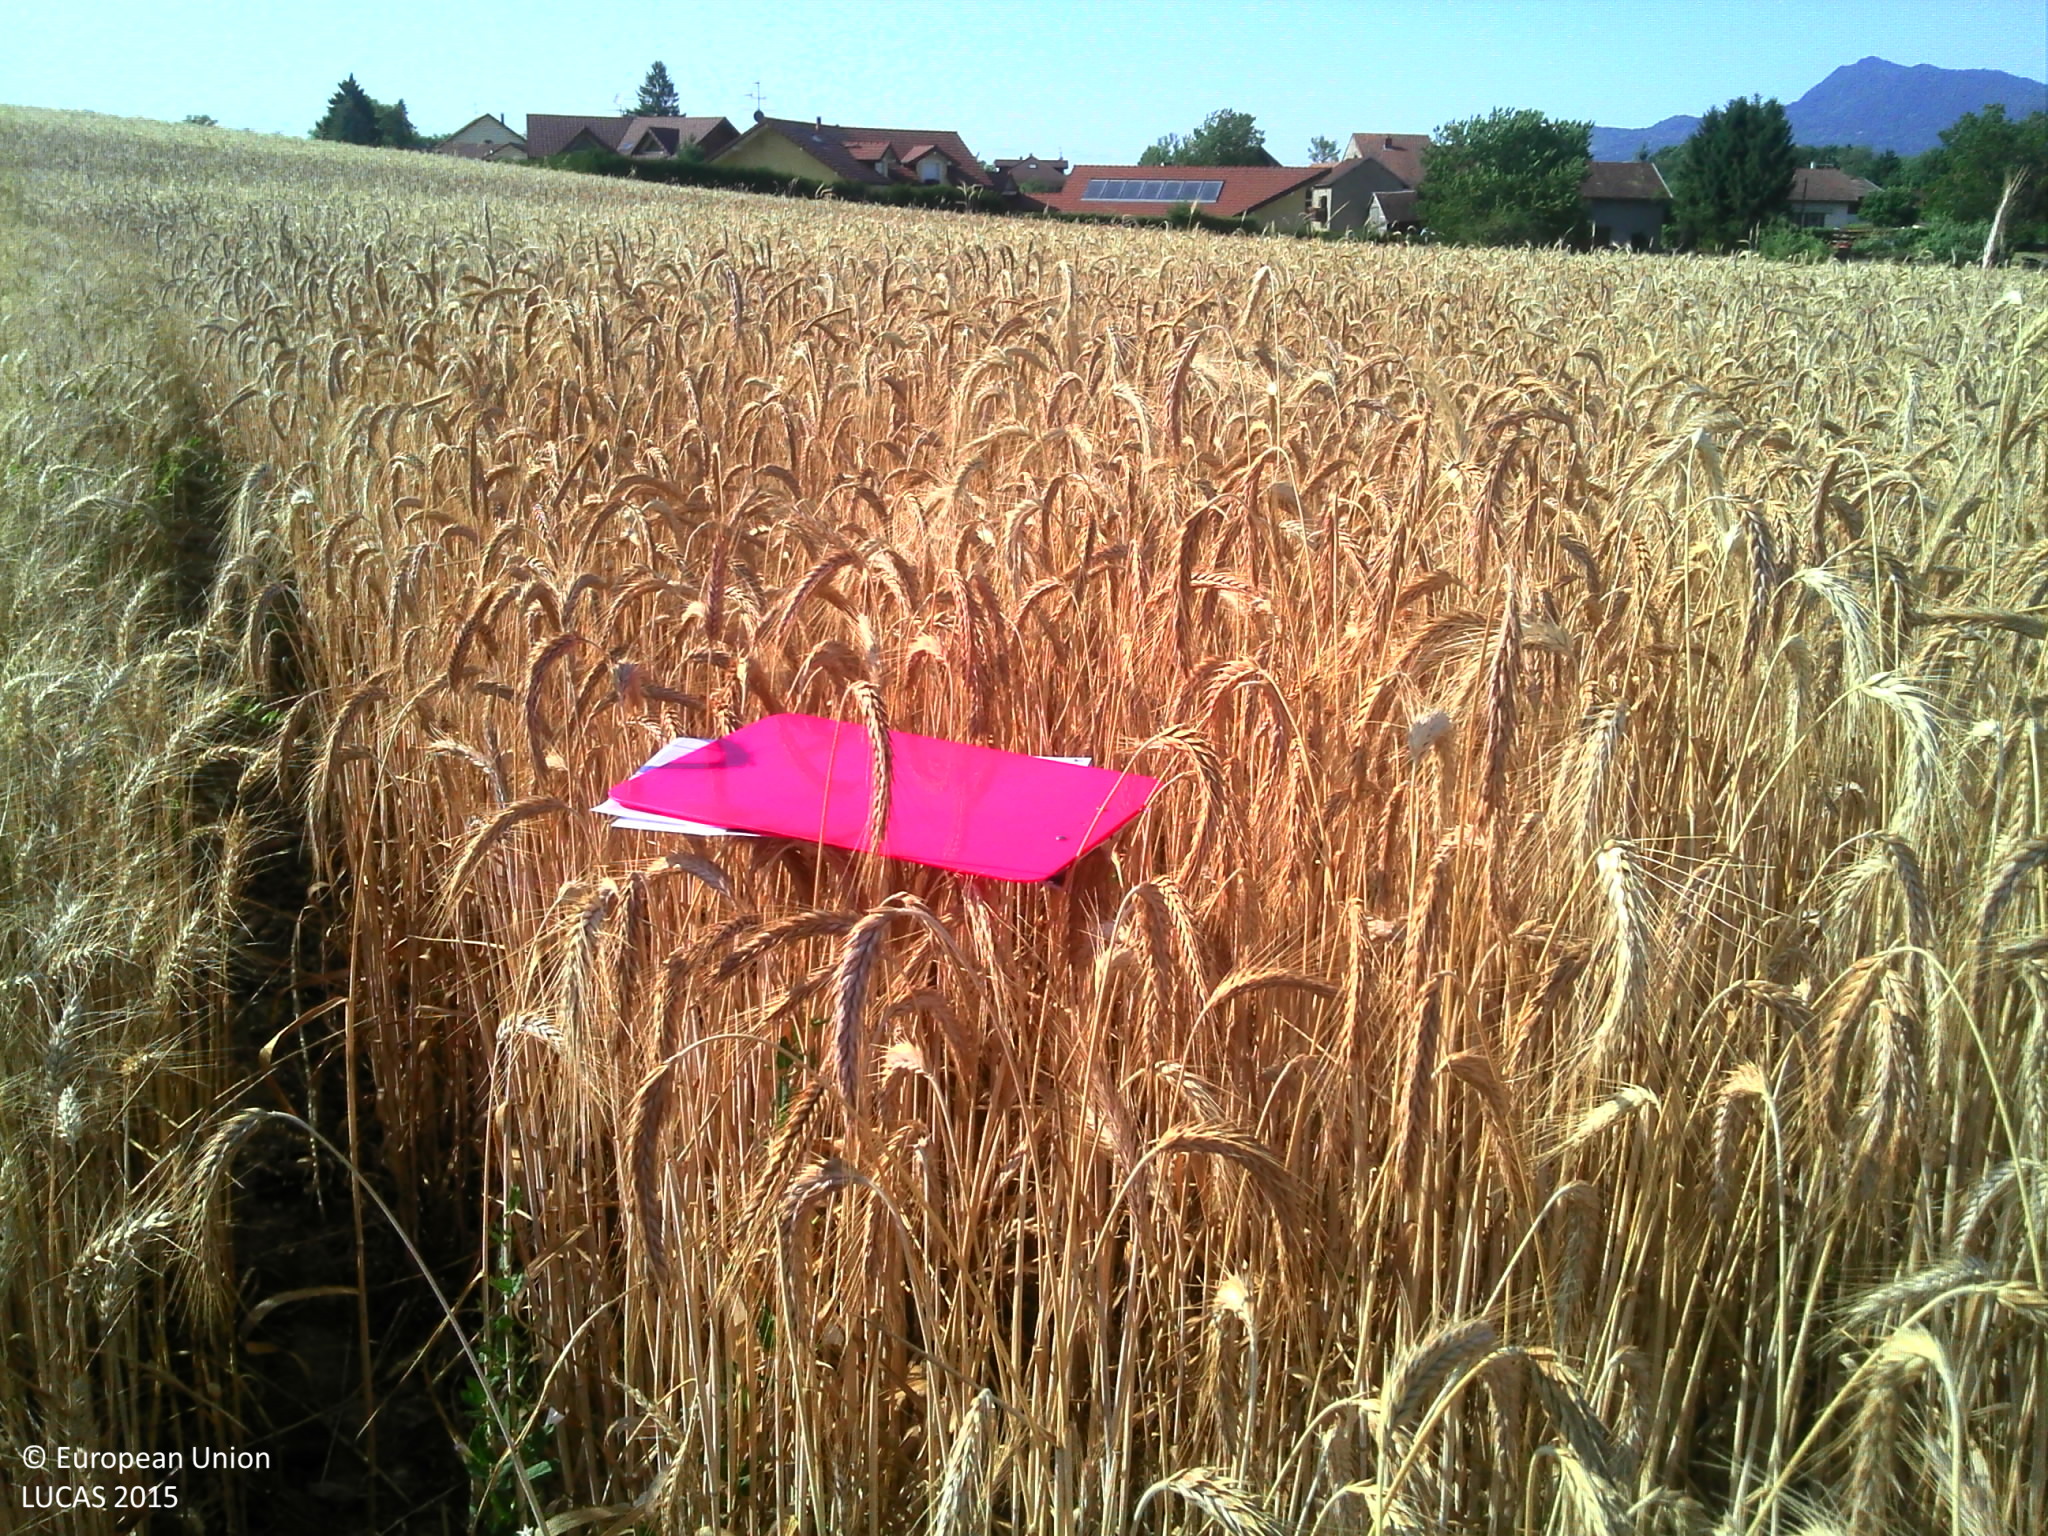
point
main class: Cropland
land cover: Rye
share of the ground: > 75 %
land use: Agriculture (excluding fallow land and kitchen gardens)
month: July
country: FR
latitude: 46.0895
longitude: 6.3177
